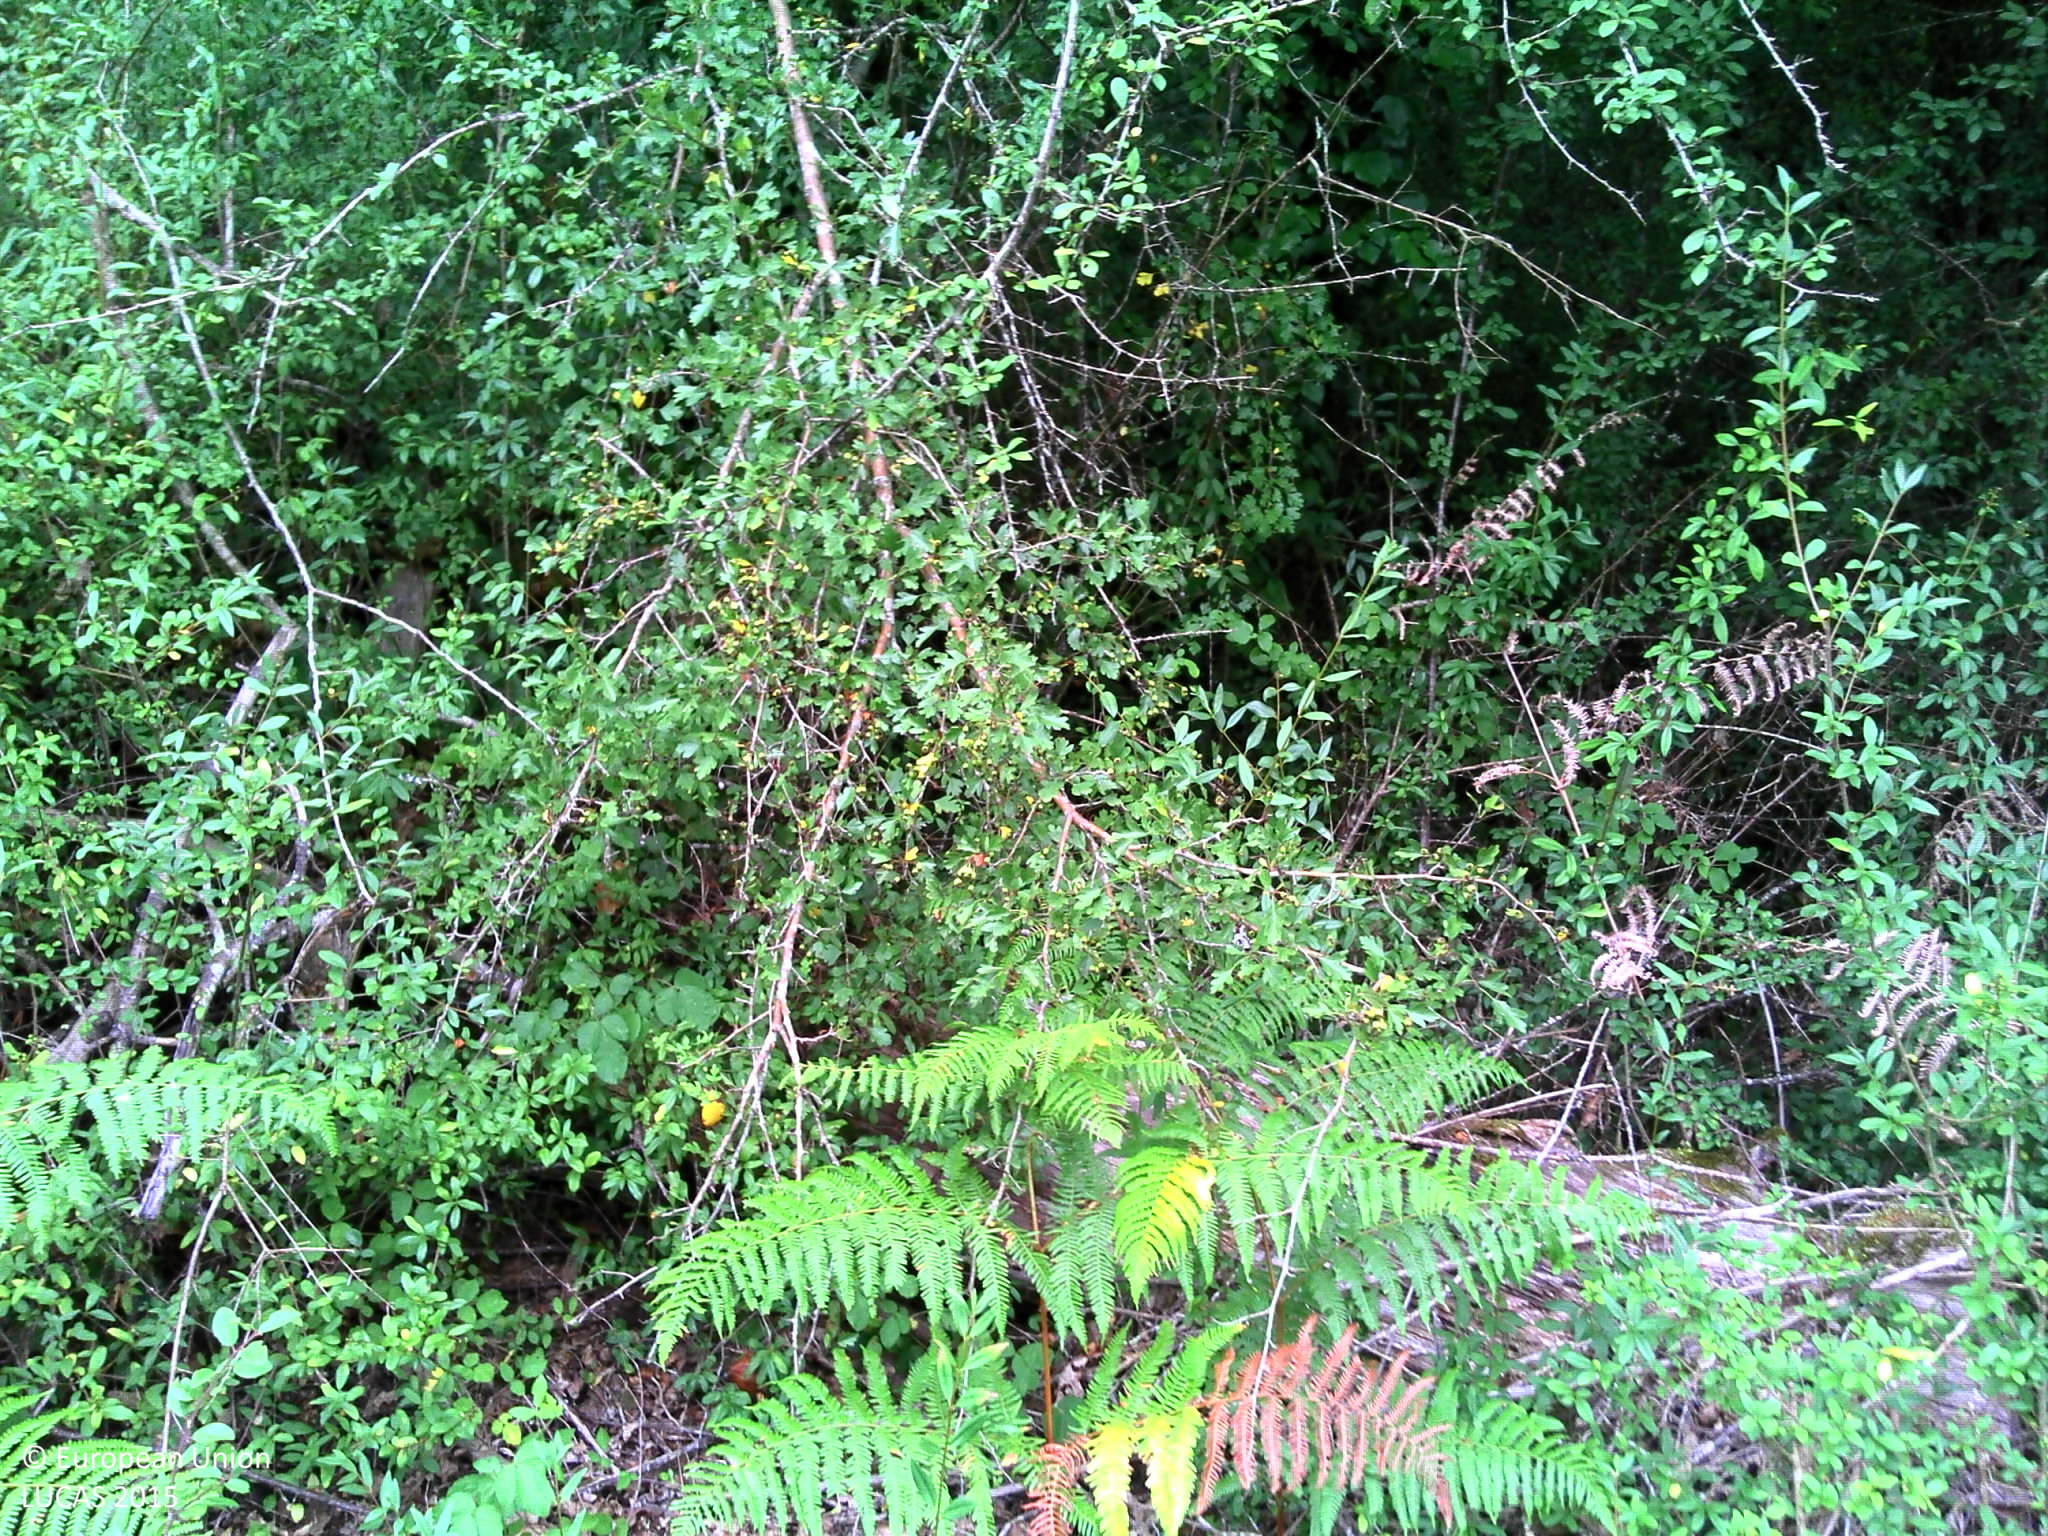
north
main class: Woodland
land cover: Broadleaved woodland
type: acidophilous oak and oak-birch forest
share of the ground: > 75 %
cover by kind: broadleaved forest trees 65 %, herbaceous plants 20 %, shrubs 15 %
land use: Forestry
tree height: > 5 m
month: July
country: FR
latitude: 45.0464
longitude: 0.7866
